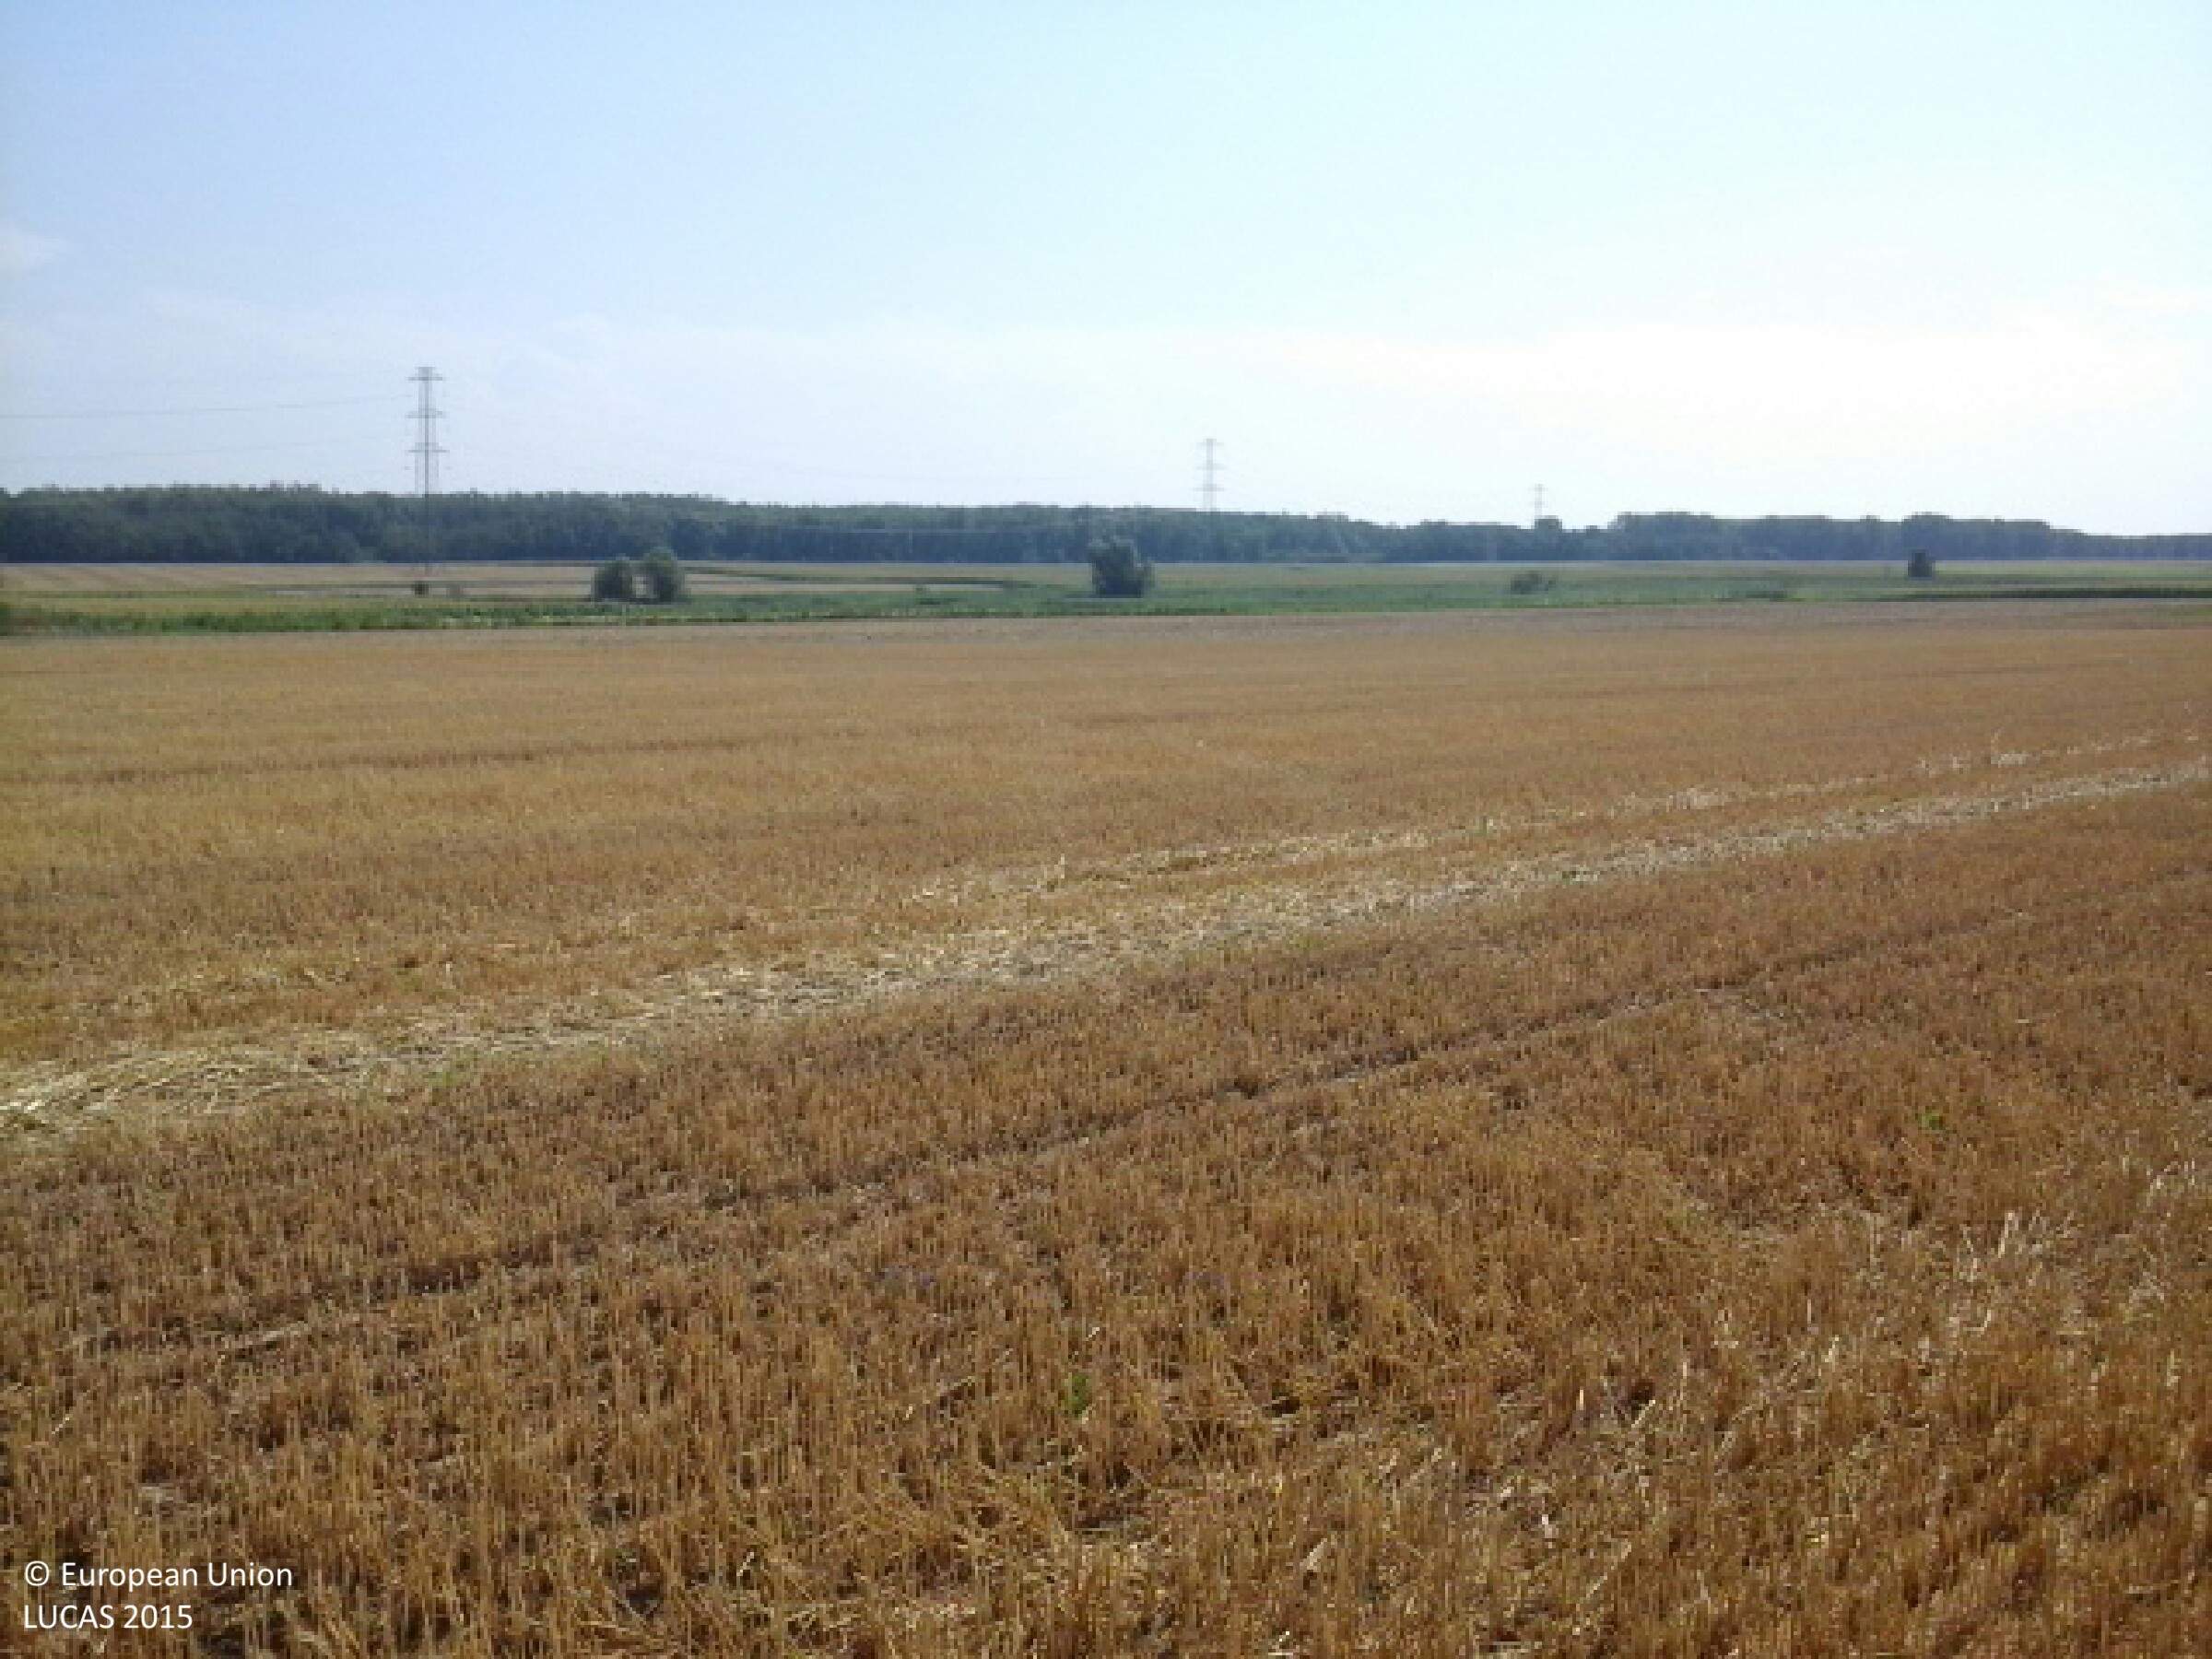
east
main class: Cropland
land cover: Triticale
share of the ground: 10 - 25 %
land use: Agriculture (excluding fallow land and kitchen gardens)
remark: Harvested field
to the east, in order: Triticale; Spontaneously vegetated surfaces
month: August
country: HU
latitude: 47.5451
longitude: 18.1030
